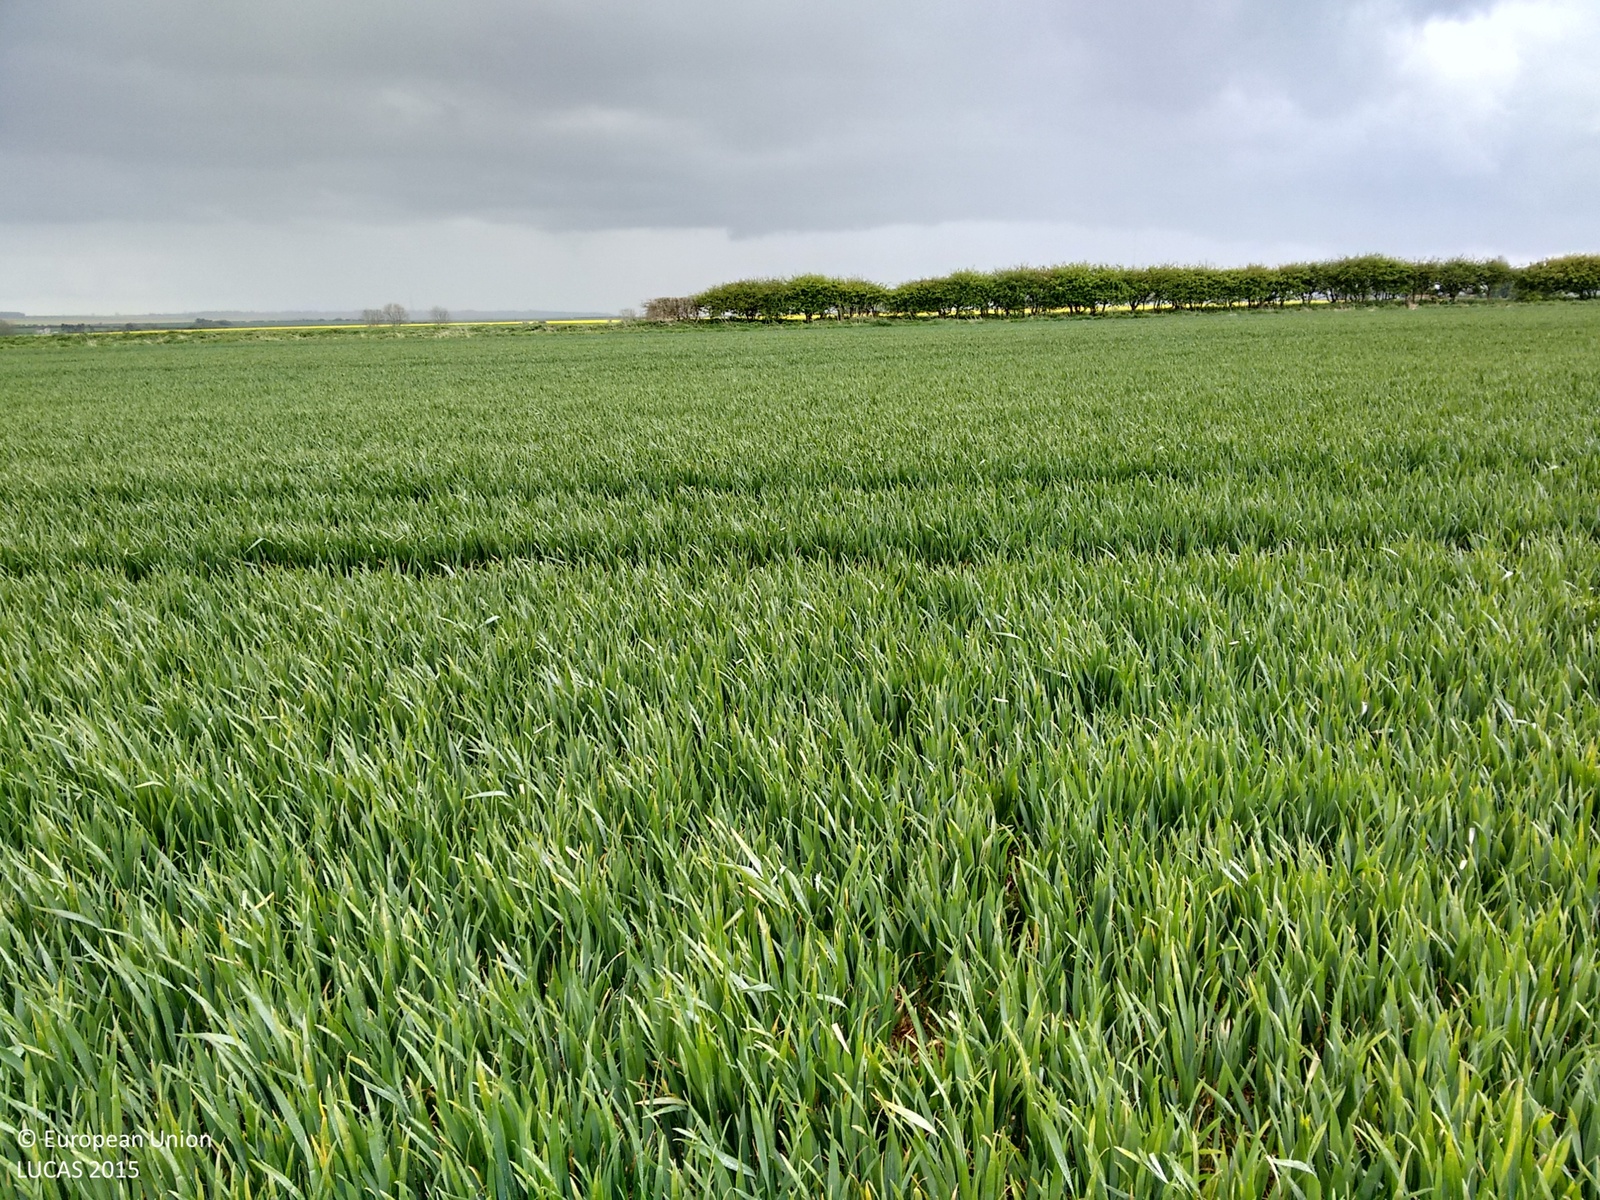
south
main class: Cropland
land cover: Barley
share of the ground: > 75 %
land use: Agriculture (excluding fallow land and kitchen gardens)
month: May
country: GB
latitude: 53.3910
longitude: -0.1533
